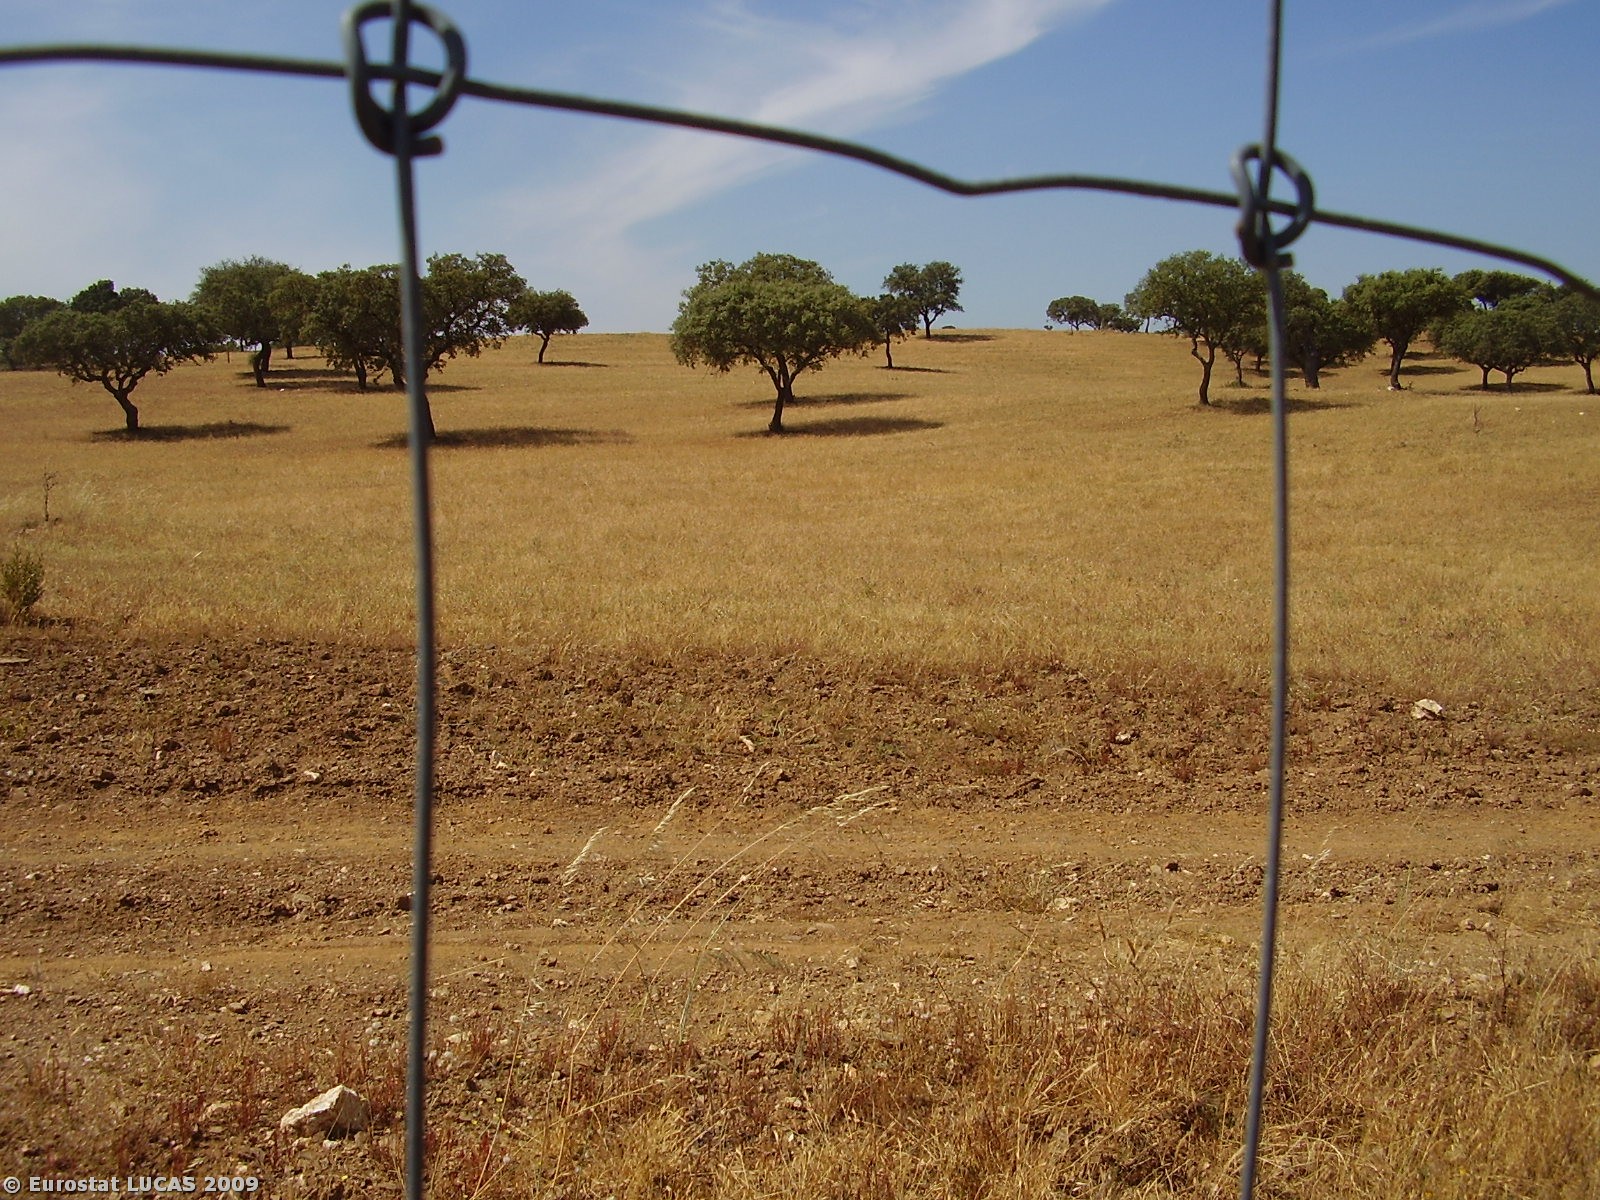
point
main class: Woodland
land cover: Broadleaved woodland
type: broadleaved evergreen forest
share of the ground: 10 - 25 %
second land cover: Spontaneously vegetated surfaces
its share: > 75 %
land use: Forestry
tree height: > 5 m
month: May
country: PT
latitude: 37.7000
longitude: -7.6068
